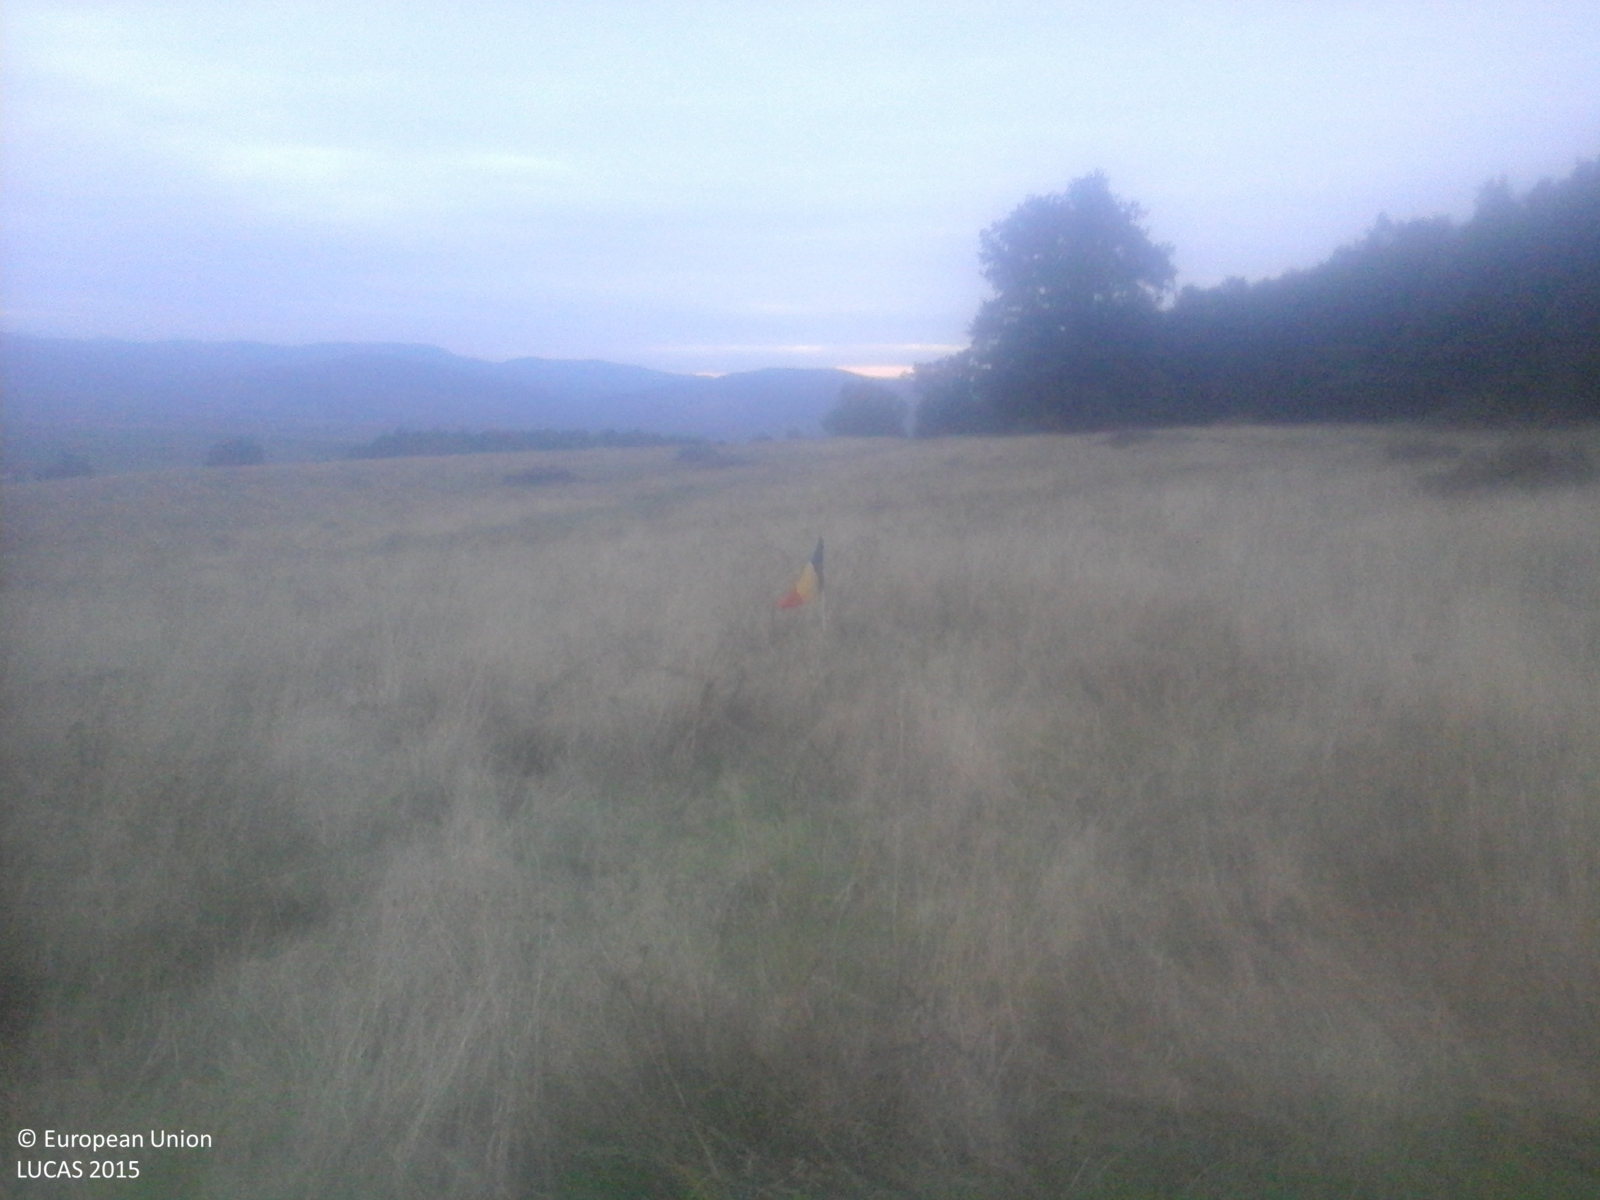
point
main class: Grassland
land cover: Grassland with sparse tree/shrub cover
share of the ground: > 75 %
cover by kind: herbaceous plants 85 %, shrubs 10 %, broadleaved forest trees 5 %
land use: Agriculture (excluding fallow land and kitchen gardens)
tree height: < 5 m
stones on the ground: < 10 %
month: September
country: RO
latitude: 45.8611
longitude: 23.3142
